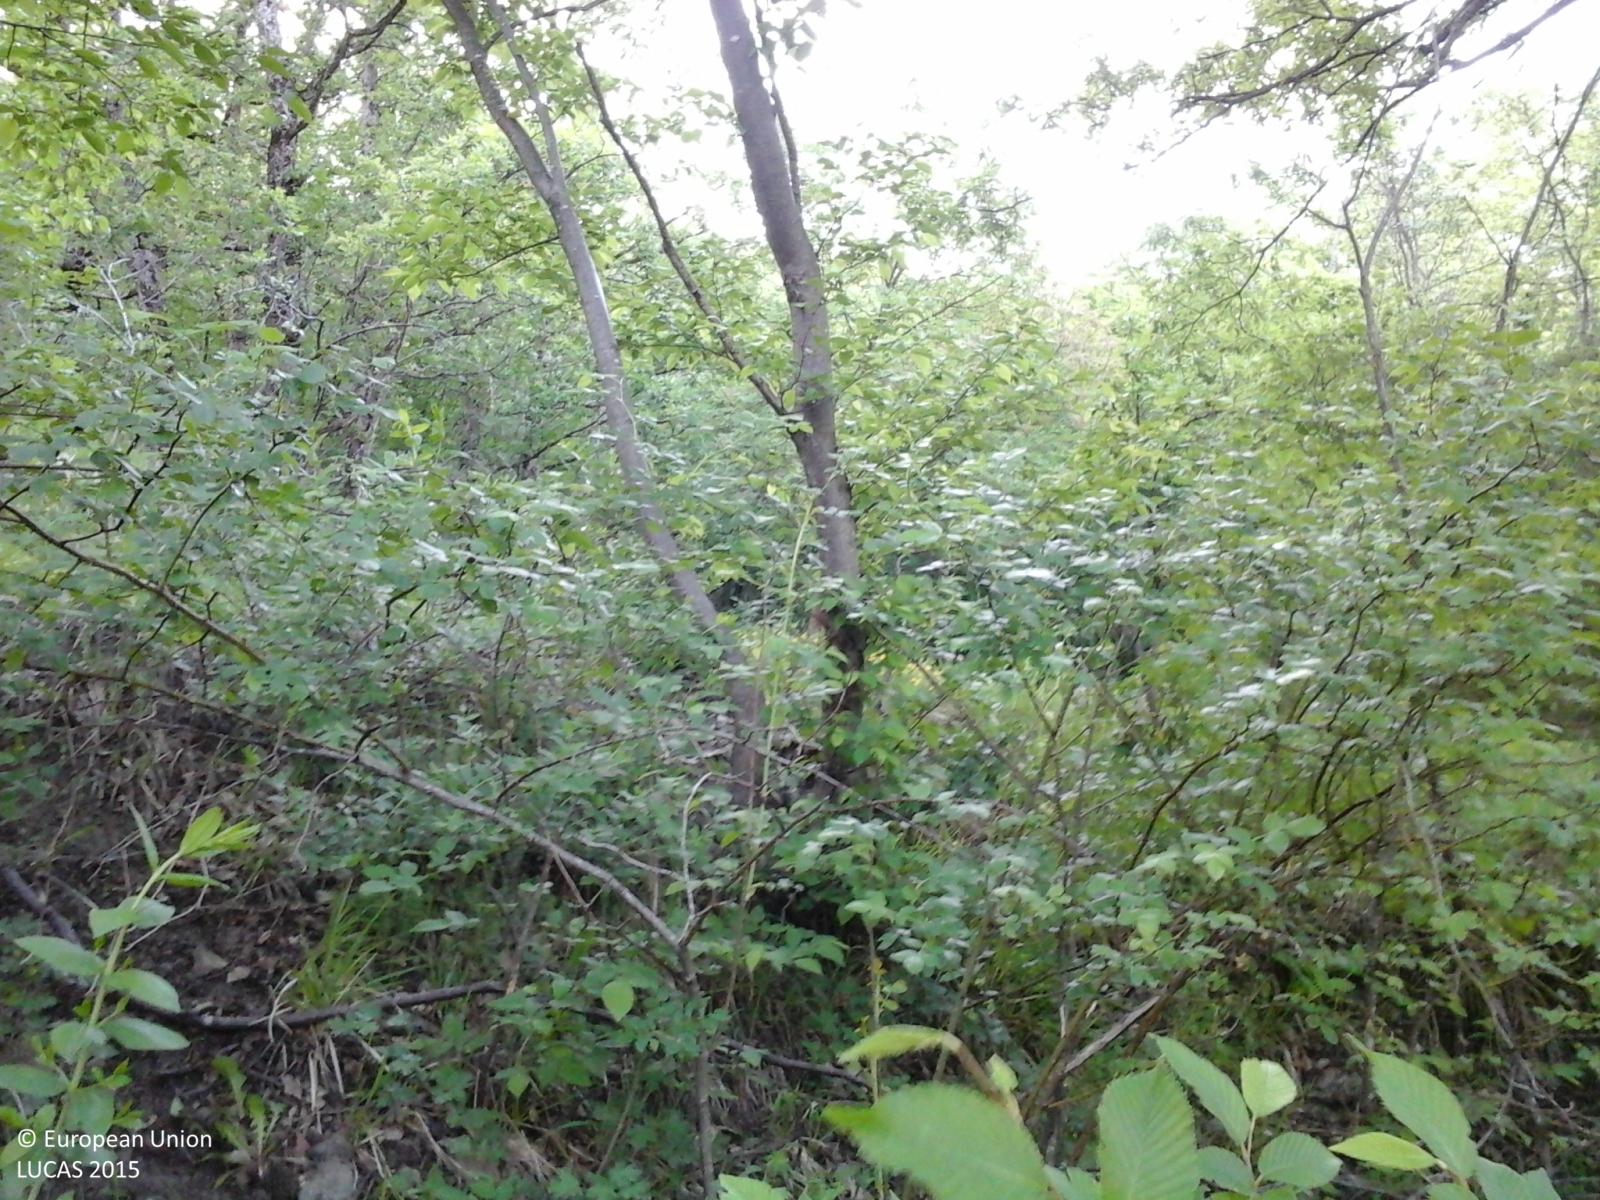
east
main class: Woodland
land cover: Broadleaved woodland
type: thermophilous deciduous forest
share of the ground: > 75 %
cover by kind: broadleaved forest trees 100 %
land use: Forestry
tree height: > 5 m
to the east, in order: Broadleaved woodland; Tracks; Broadleaved woodland; Tracks
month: May
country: IT
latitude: 44.5309
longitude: 9.9121
